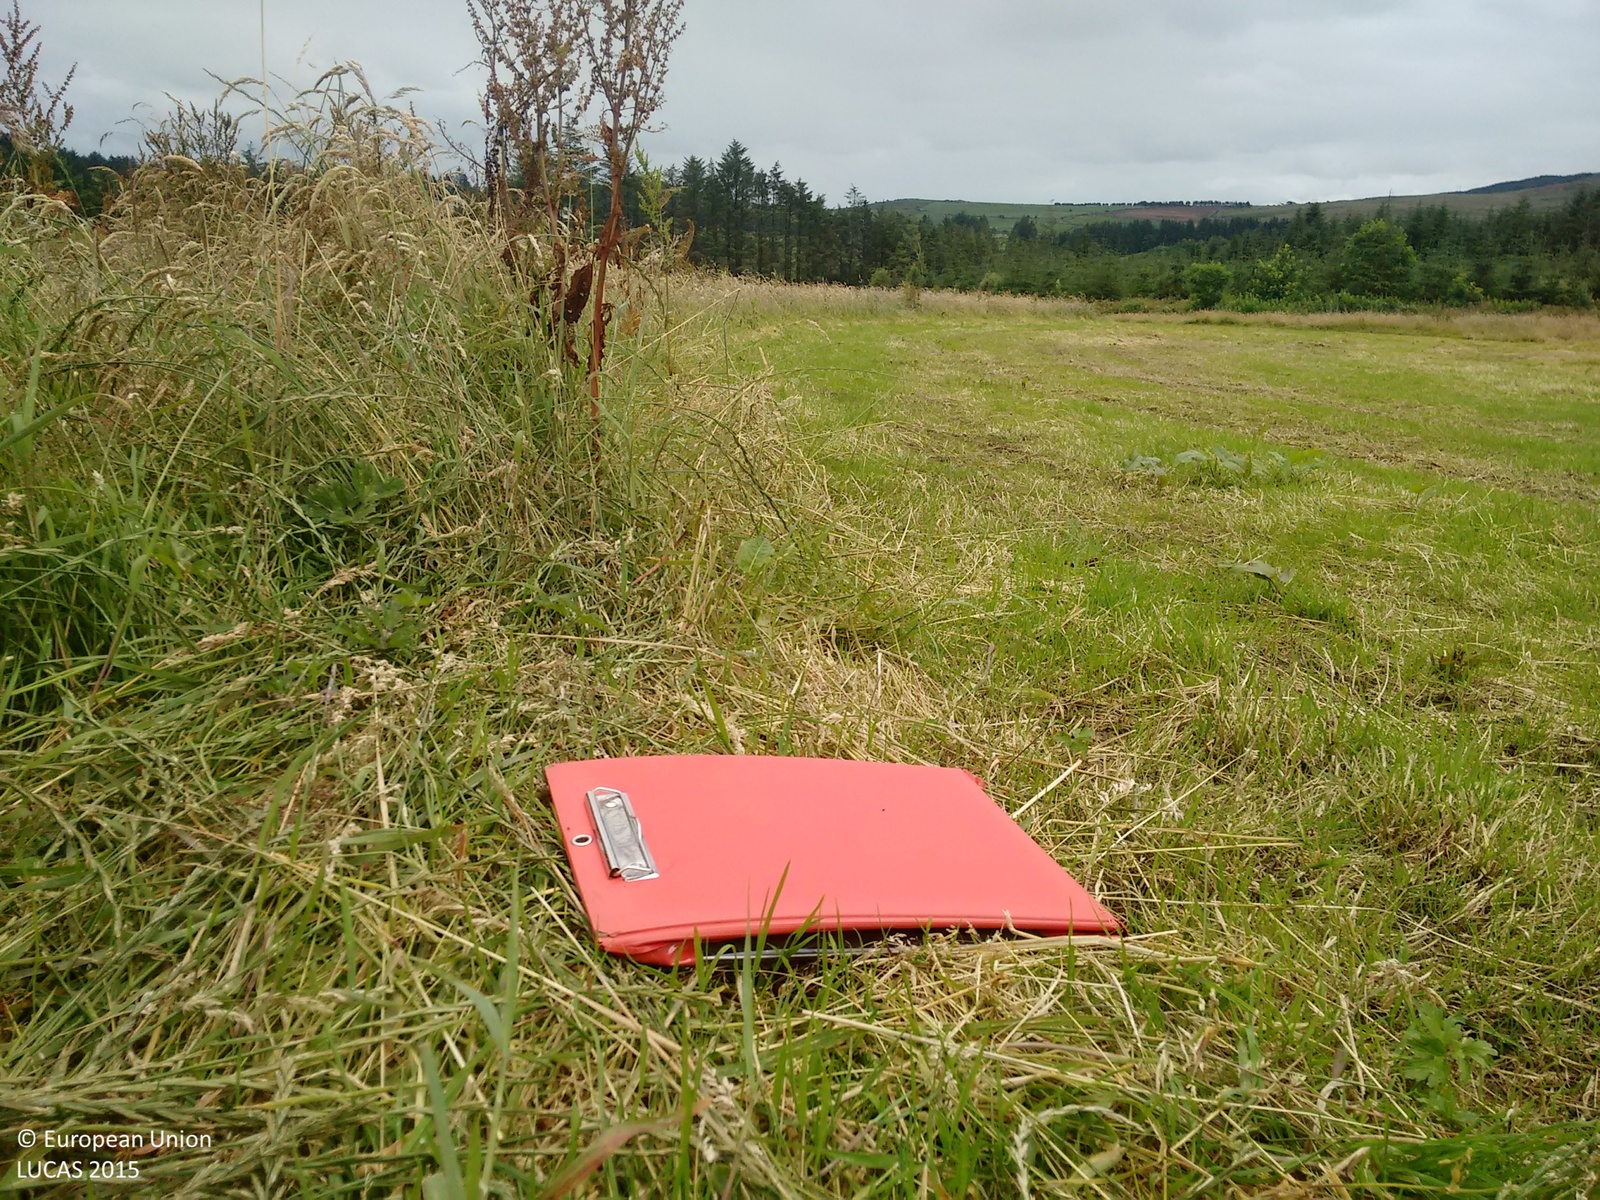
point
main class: Grassland
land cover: Grassland without tree/shrub cover
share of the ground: > 75 %
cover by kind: herbaceous plants 100 %
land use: Agriculture (excluding fallow land and kitchen gardens)
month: July
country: IE
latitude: 52.0038
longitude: -8.8986
